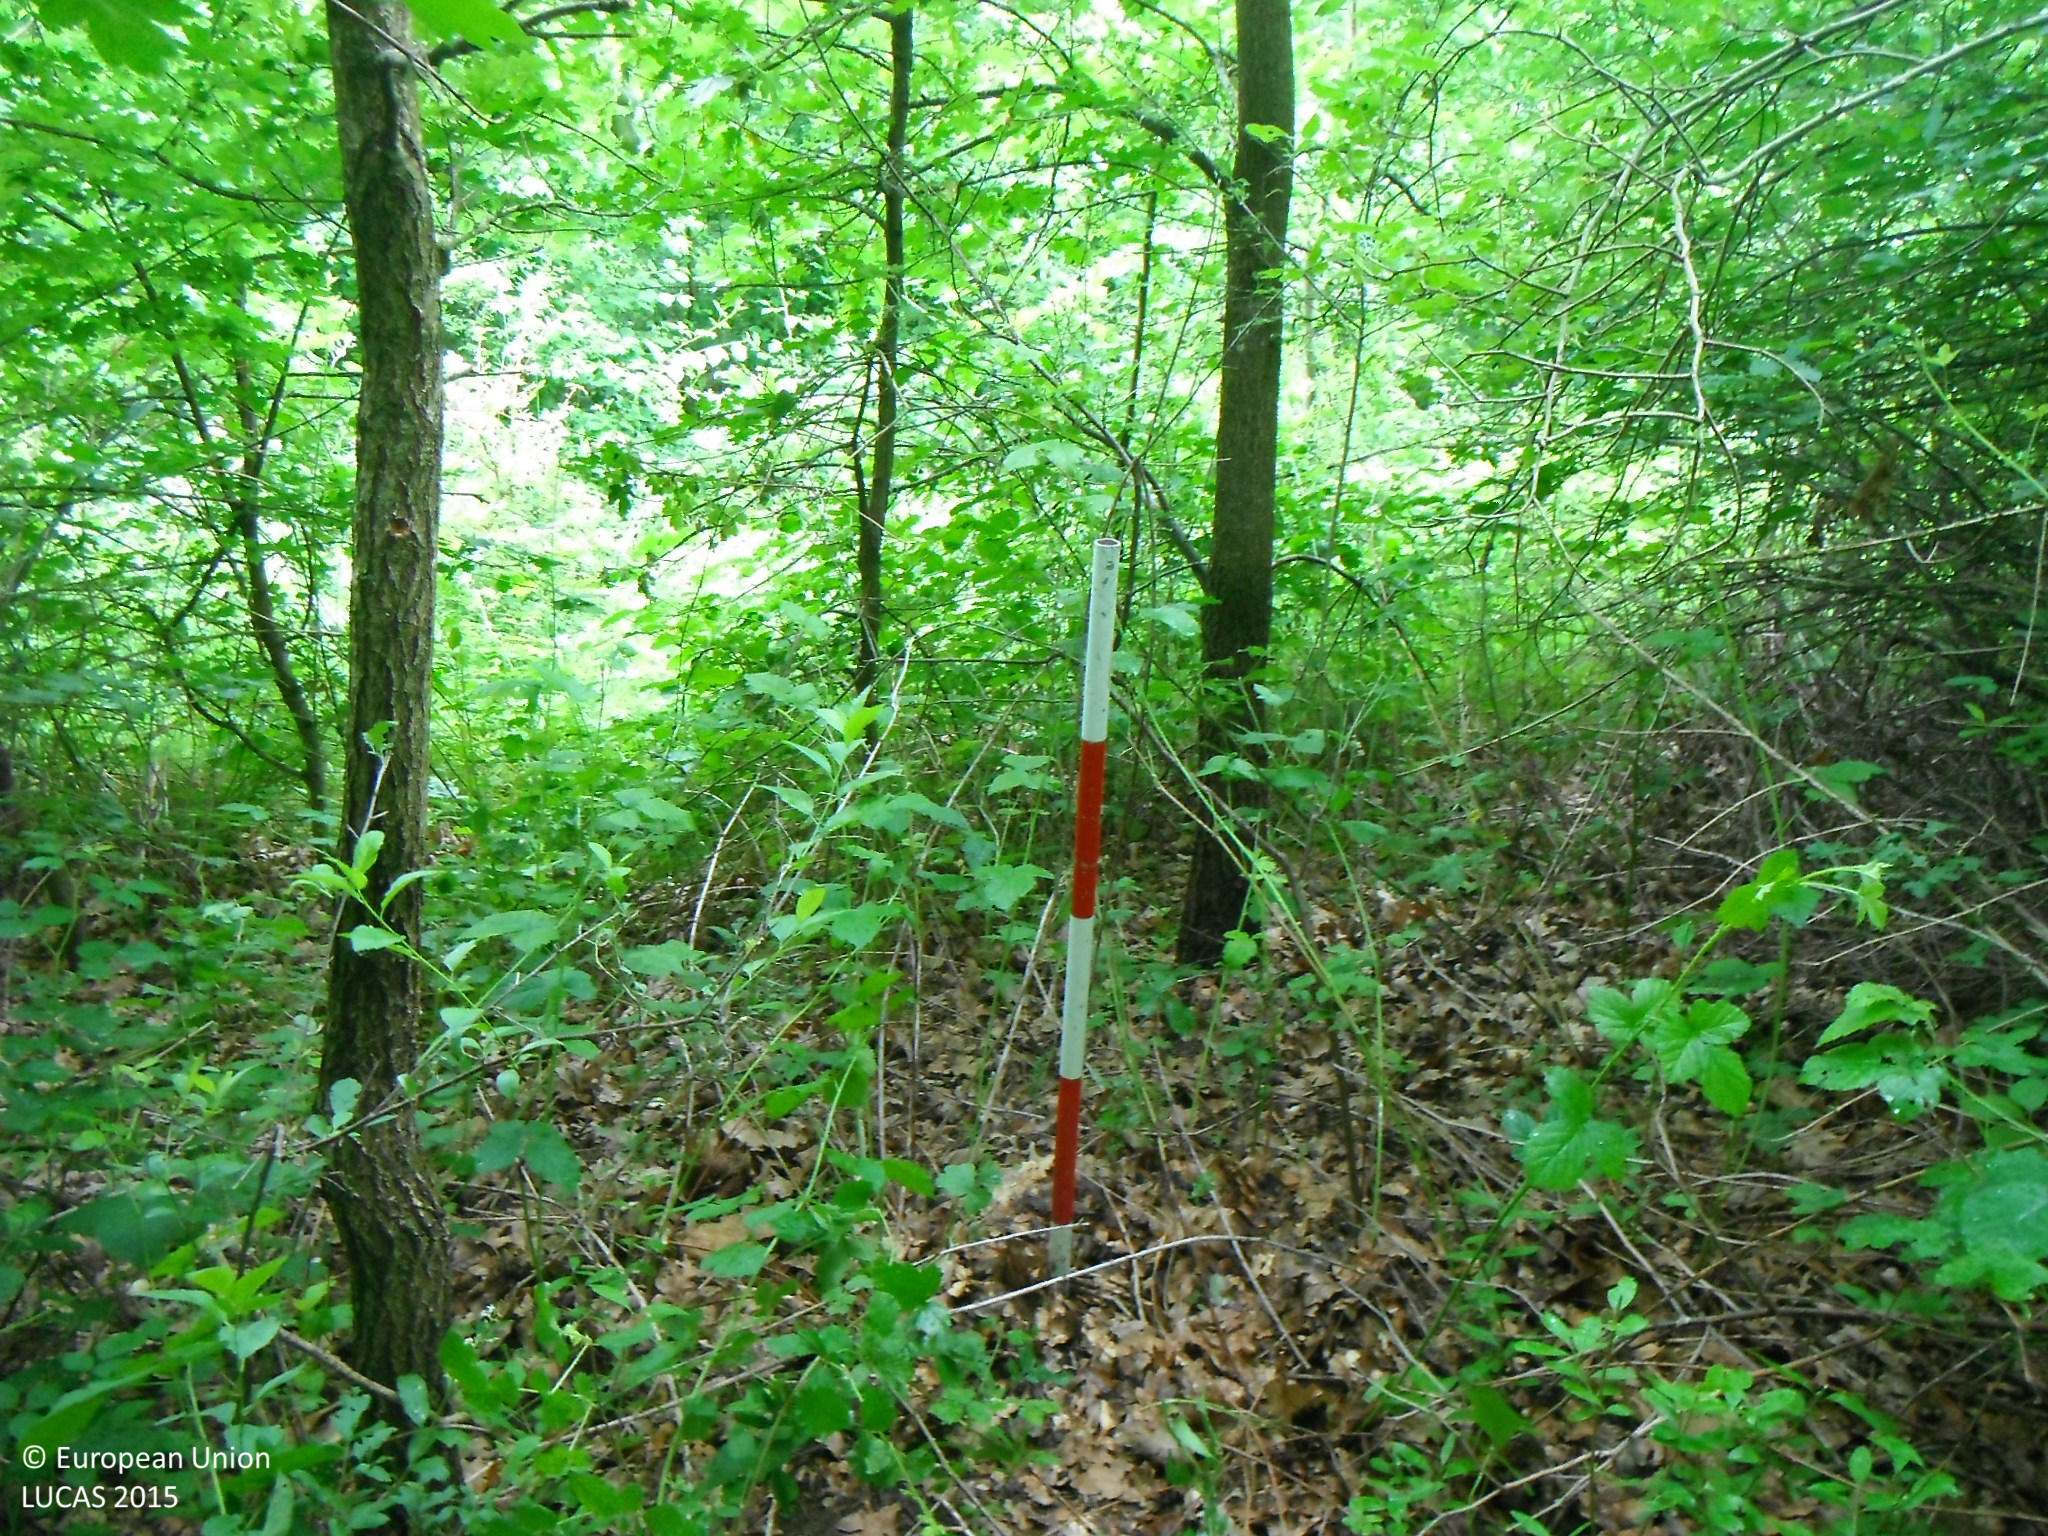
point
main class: Woodland
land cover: Broadleaved woodland
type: mesophytic deciduous forest
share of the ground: > 75 %
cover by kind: broadleaved forest trees 100 %
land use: Forestry
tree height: > 5 m
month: June
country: SK
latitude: 48.4571
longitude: 19.9953
